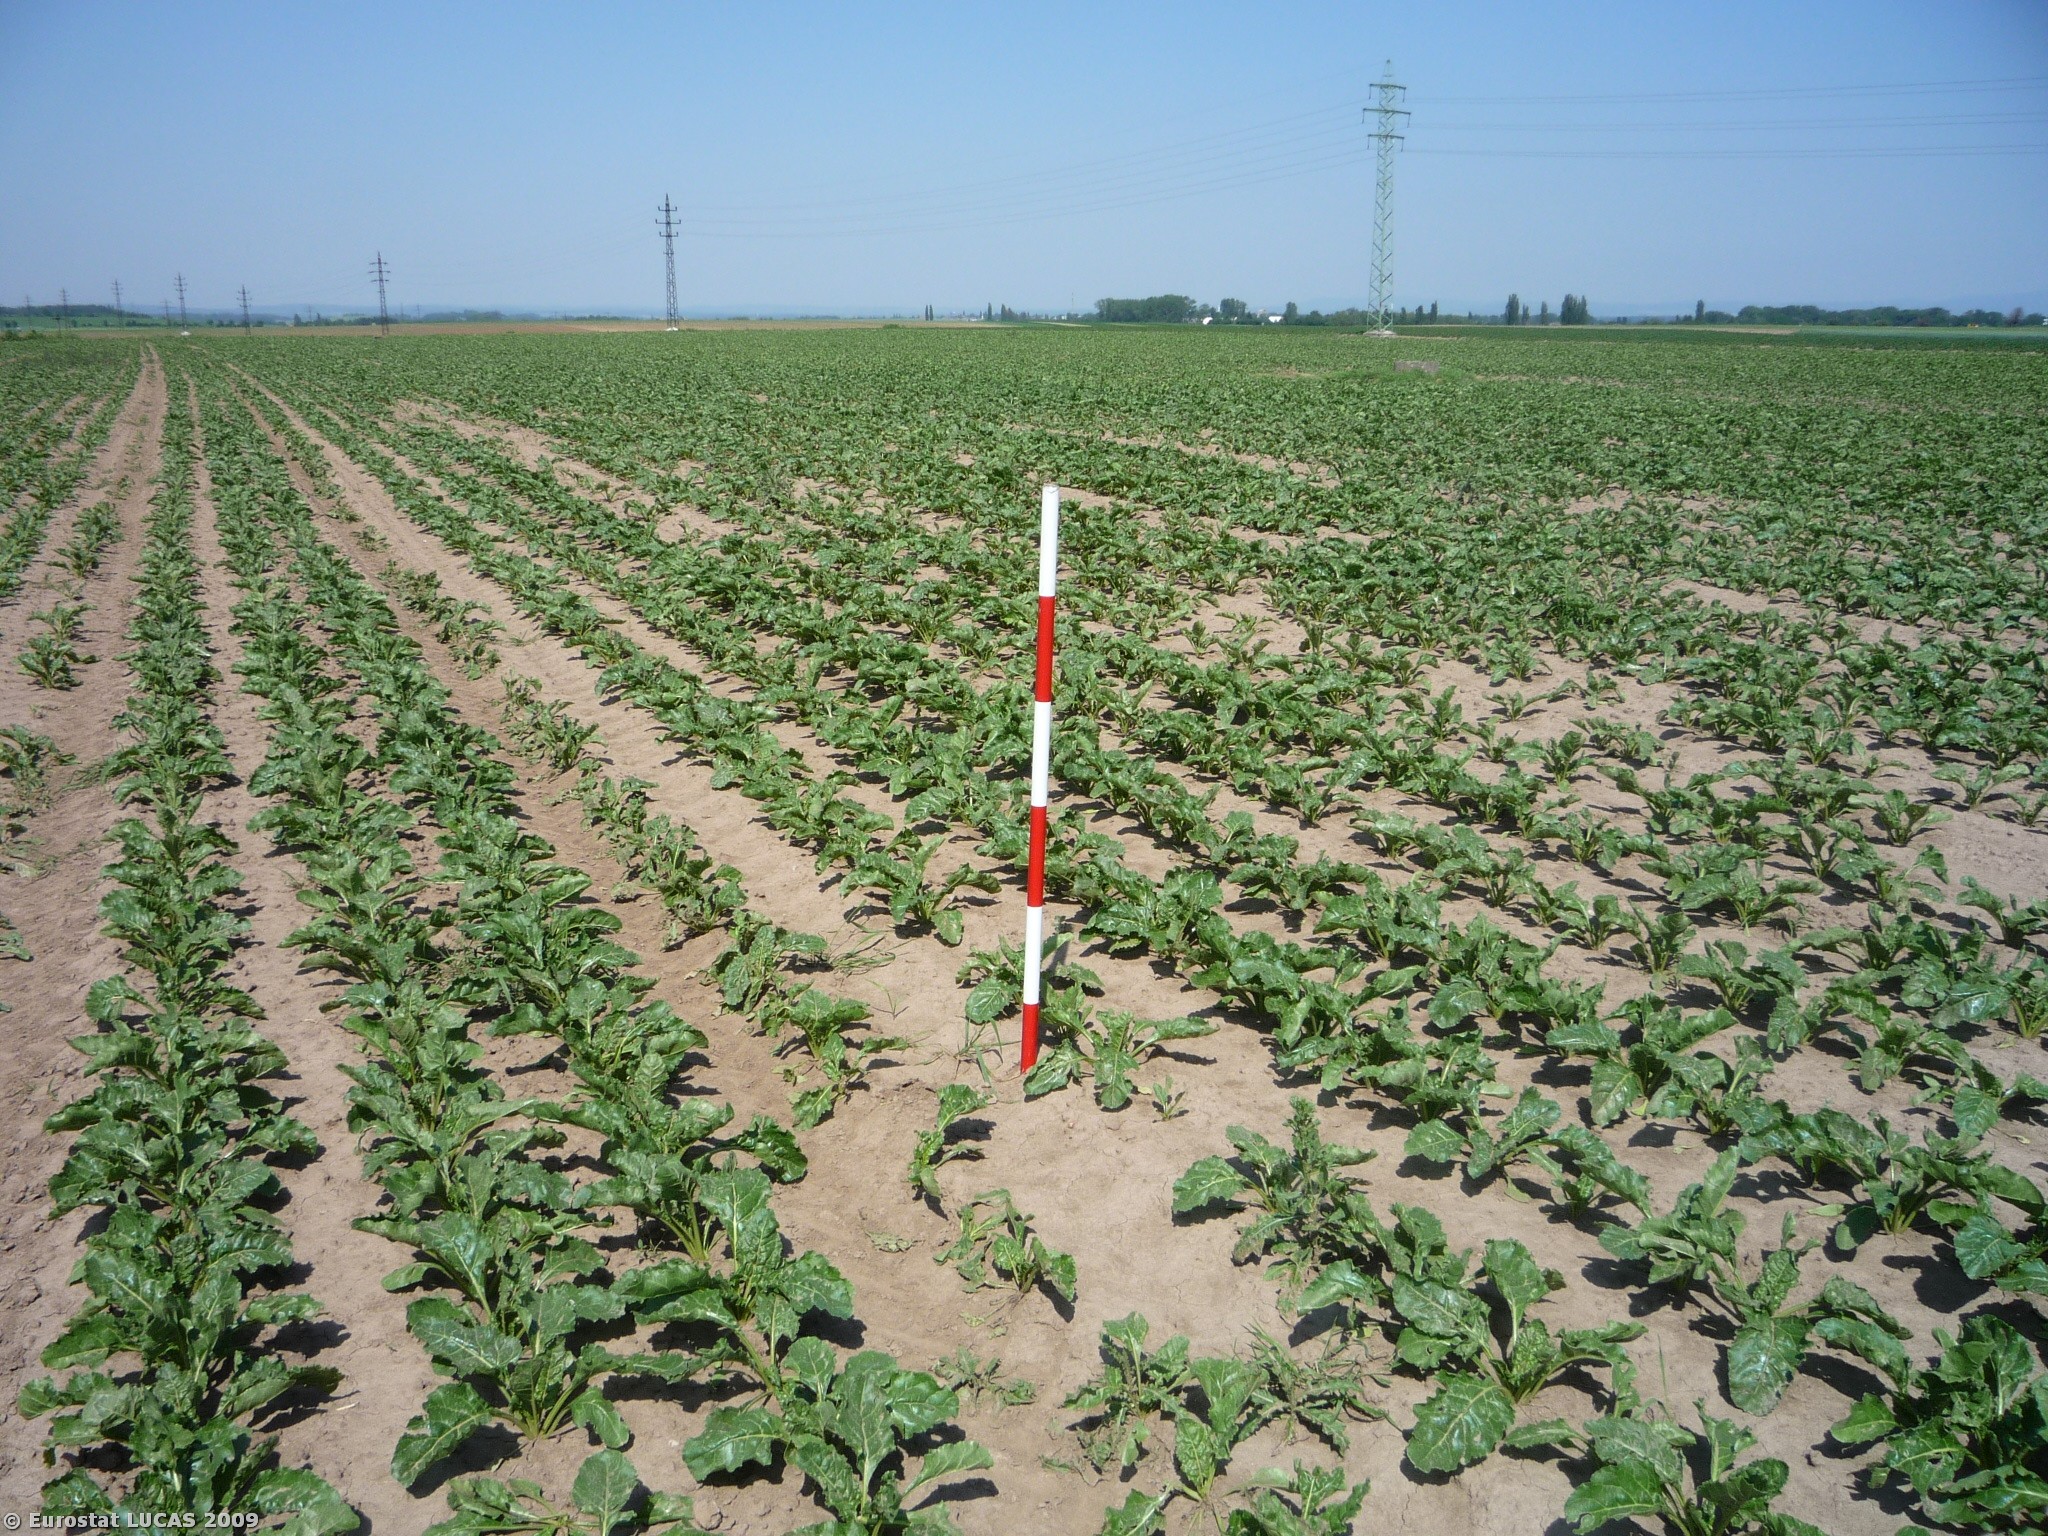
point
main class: Cropland
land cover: Sugar beet
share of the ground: 10 - 25 %
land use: Agriculture (excluding fallow land and kitchen gardens)
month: May
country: CZ
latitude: 50.2710
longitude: 15.7996
